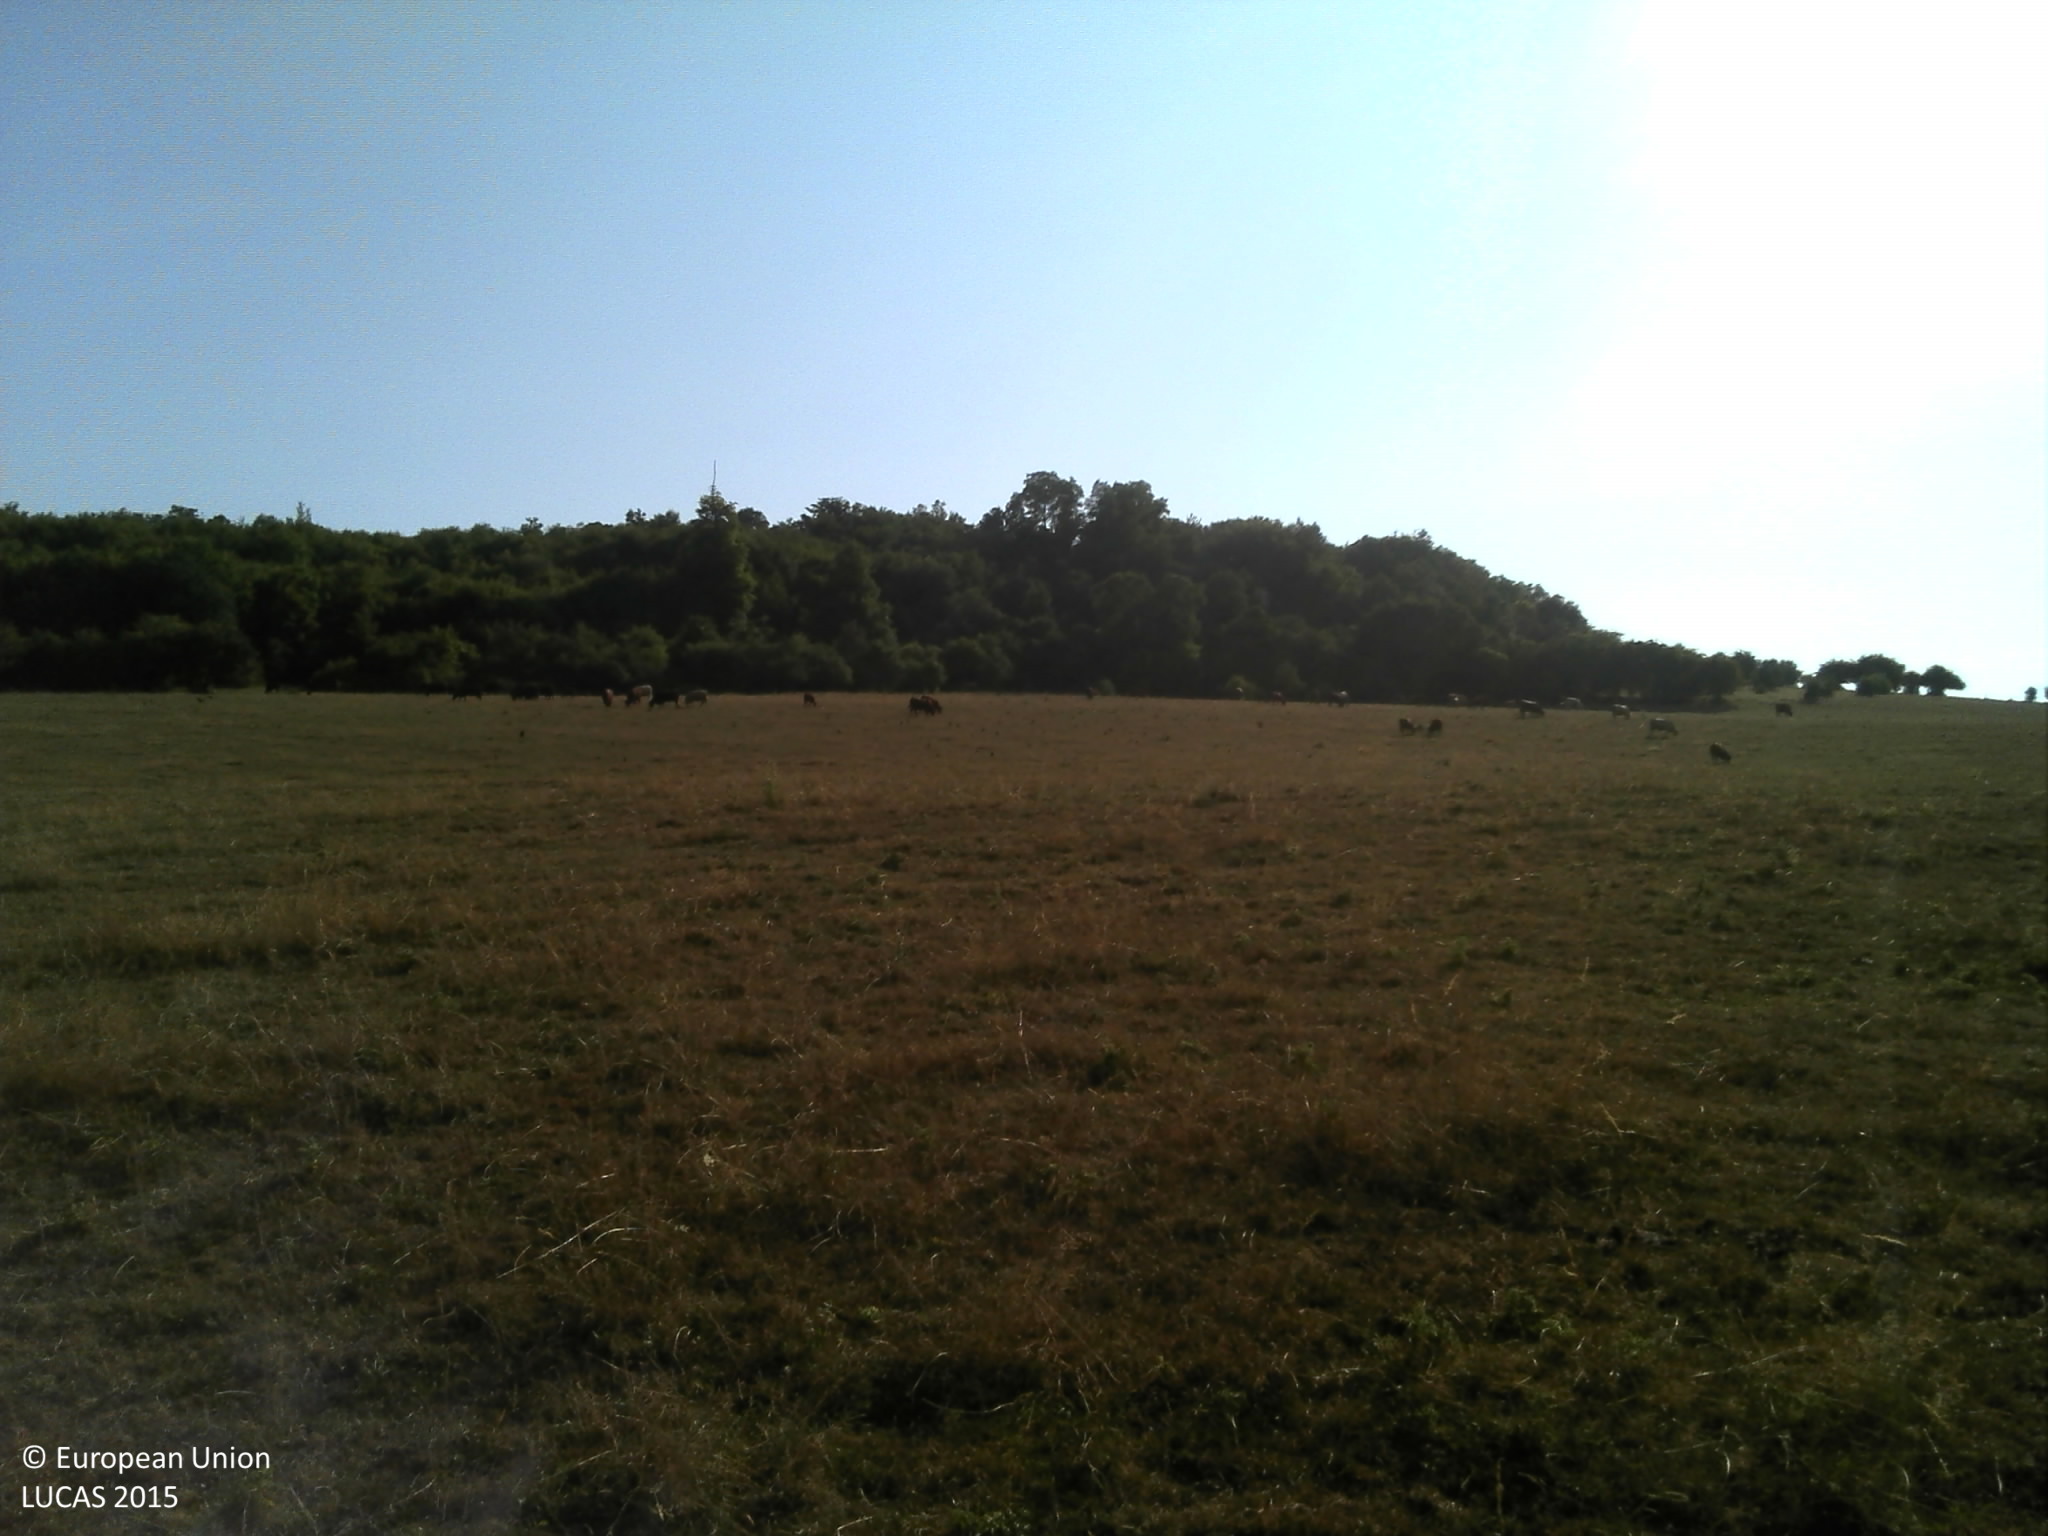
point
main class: Grassland
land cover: Grassland without tree/shrub cover
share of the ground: > 75 %
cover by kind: herbaceous plants 100 %
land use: Agriculture (excluding fallow land and kitchen gardens)
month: July
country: FR
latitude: 49.1129
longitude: 6.7808
